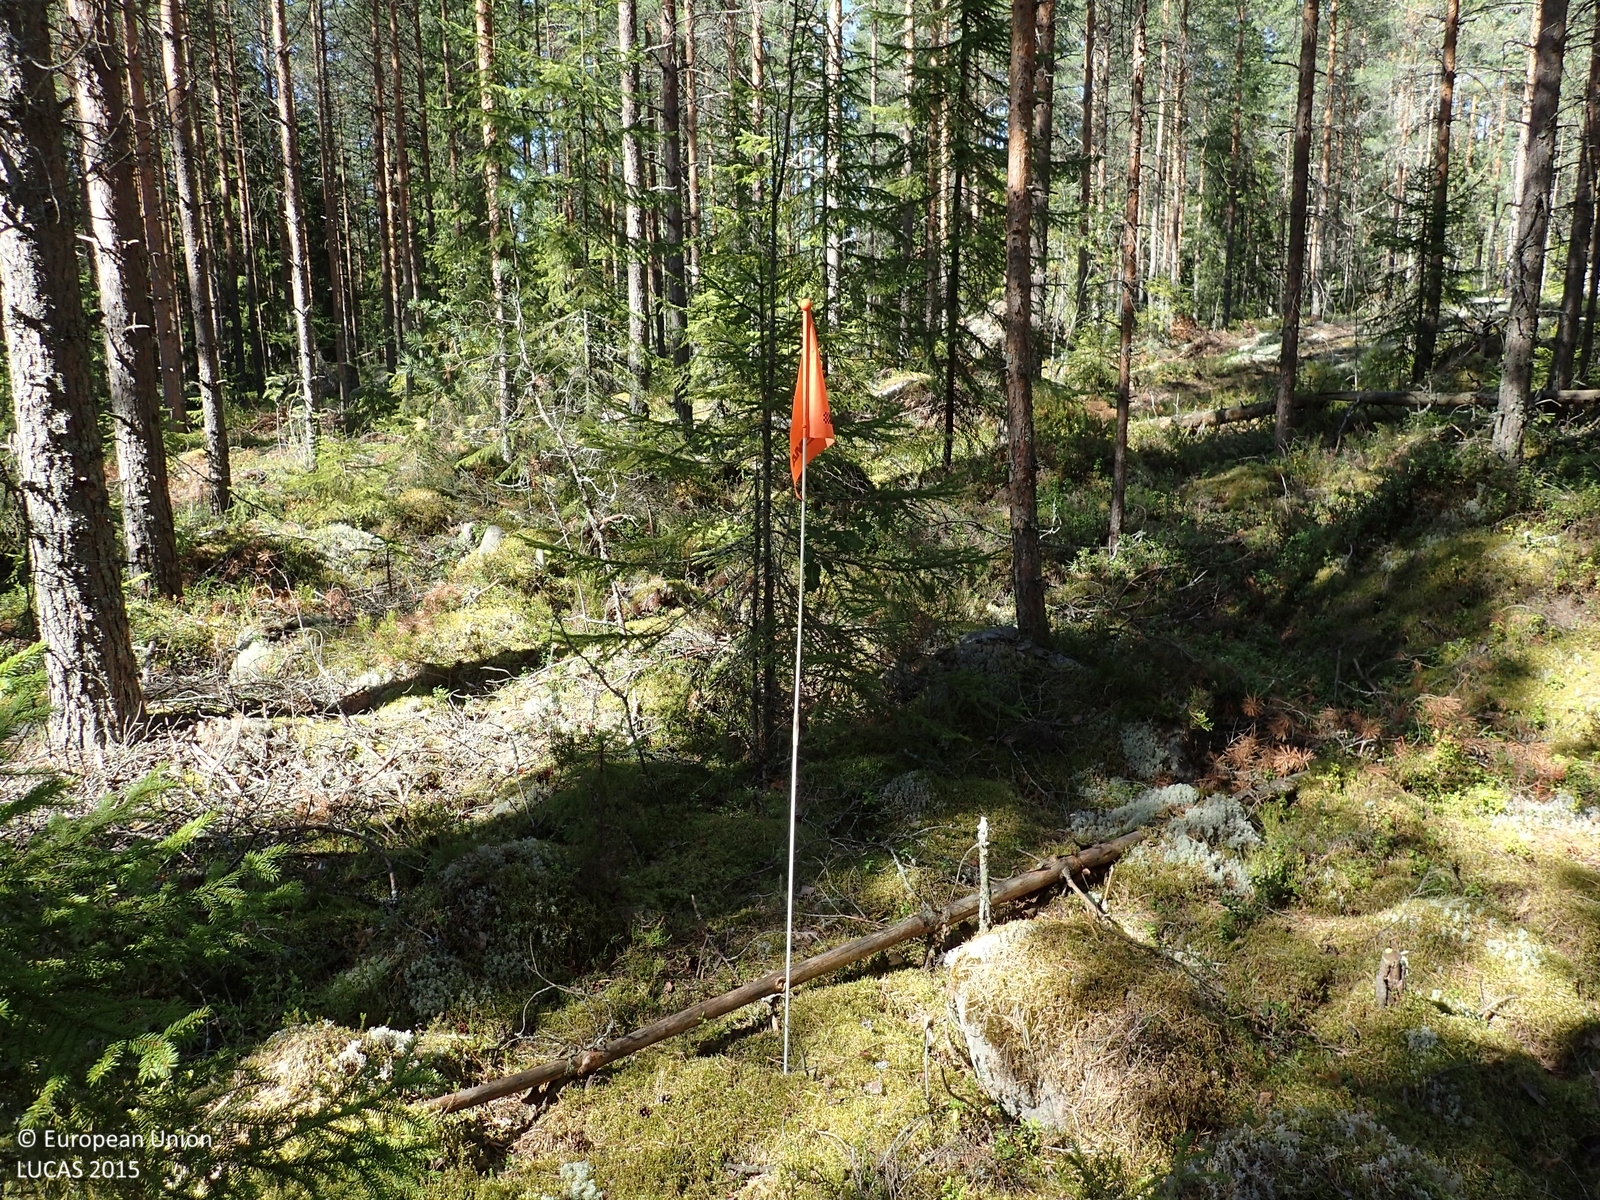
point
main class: Woodland
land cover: Pine dominated coniferous woodland
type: boreal forest
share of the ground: 50 - 75 %
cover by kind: coniferous forest trees 55 %, shrubs 25 %, lichens and mosses 15 %, broadleaved forest trees 5 %
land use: Forestry
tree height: > 5 m
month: August
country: FI
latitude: 62.5418
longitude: 22.5559
